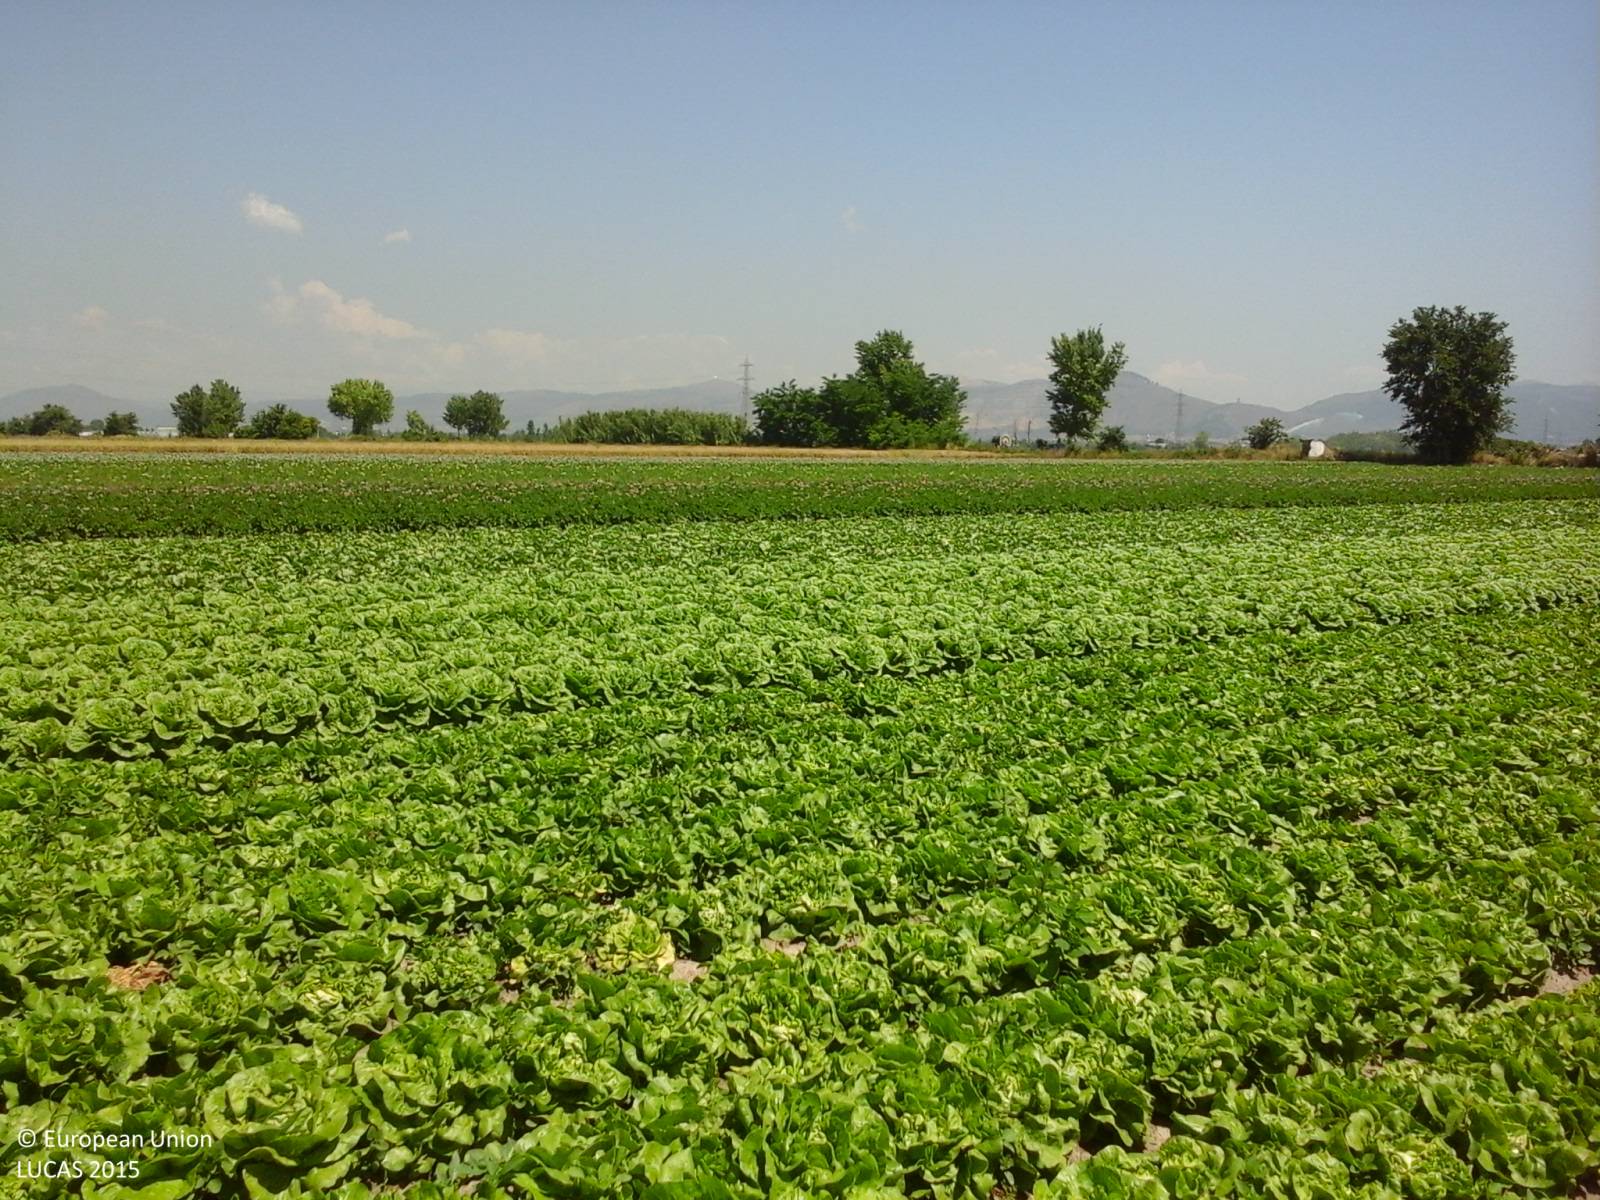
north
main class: Cropland
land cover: Other fresh vegetables
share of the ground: > 75 %
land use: Agriculture (excluding fallow land and kitchen gardens)
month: June
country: IT
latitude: 40.9864
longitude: 14.3446
